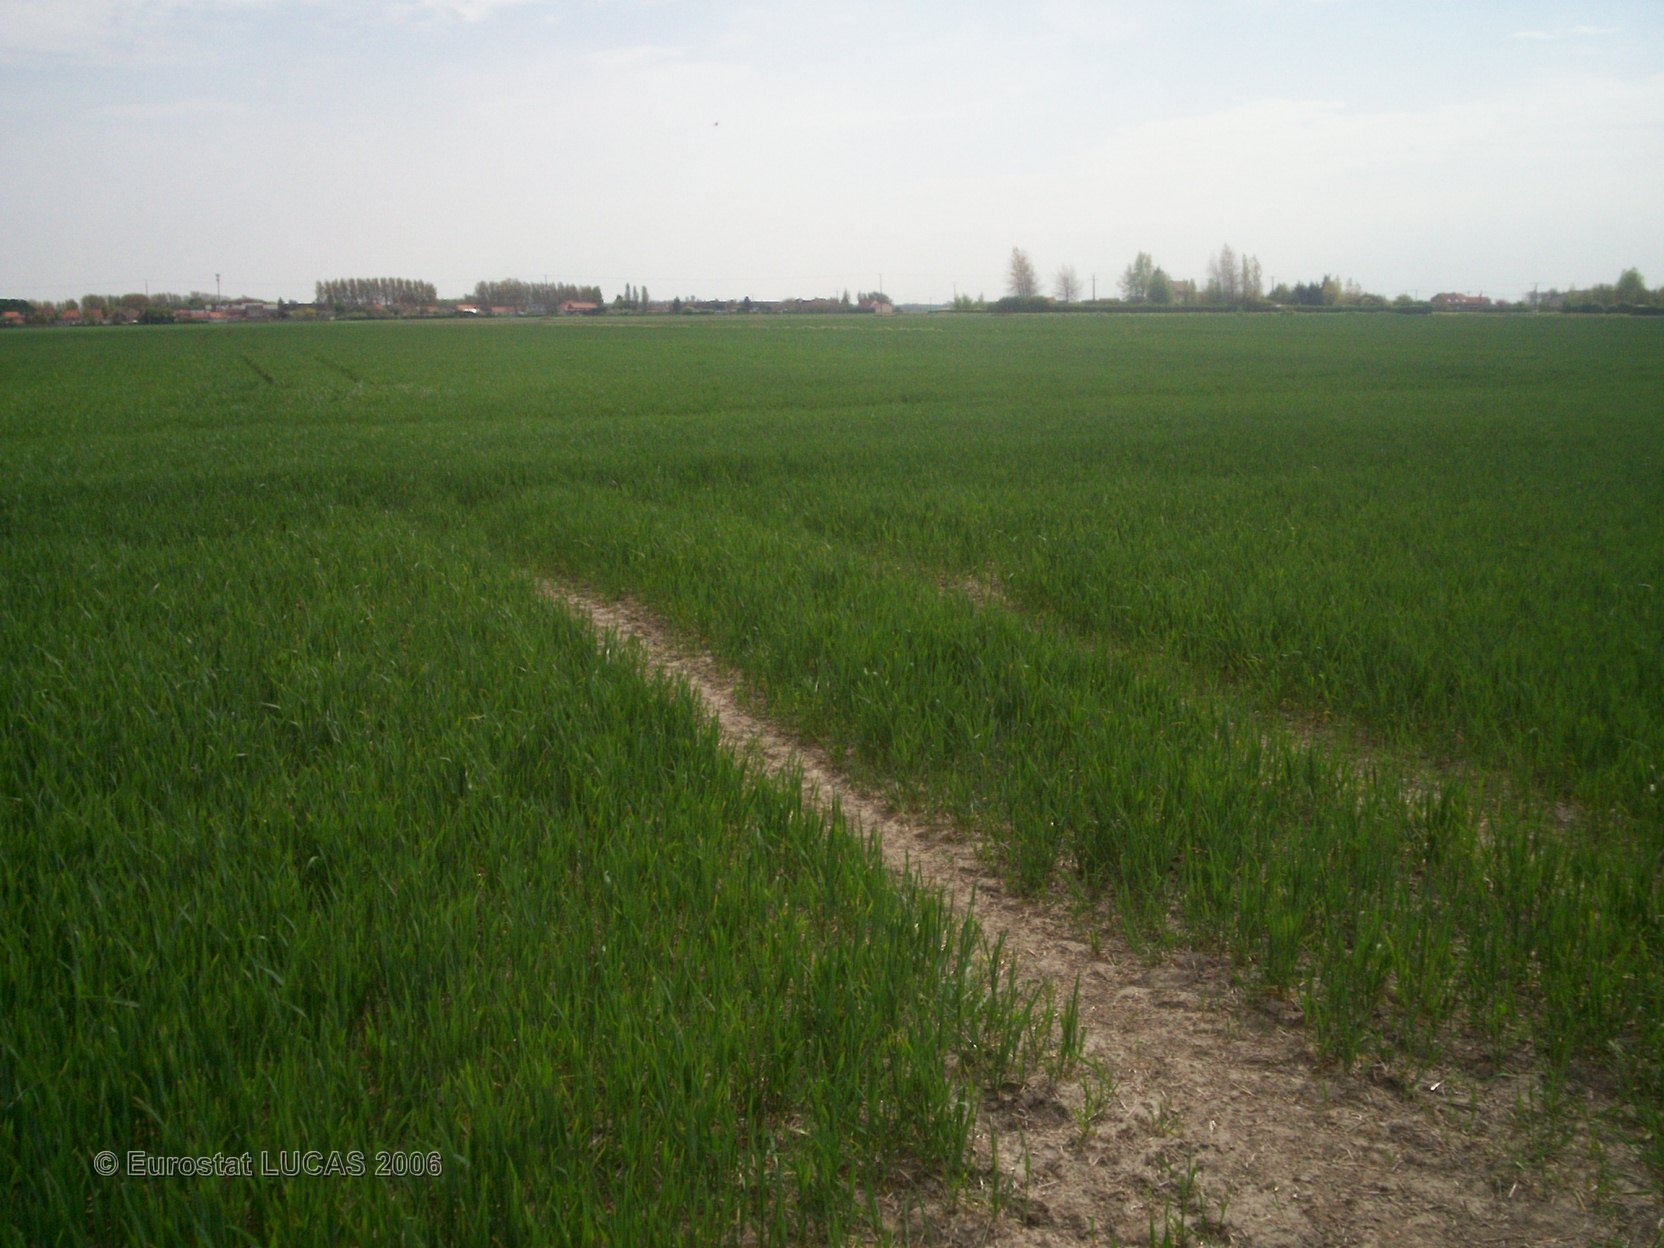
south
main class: Cropland
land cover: Common wheat
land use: Agriculture (excluding fallow land and kitchen gardens)
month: May
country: FR
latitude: 50.9739
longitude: 2.3385
